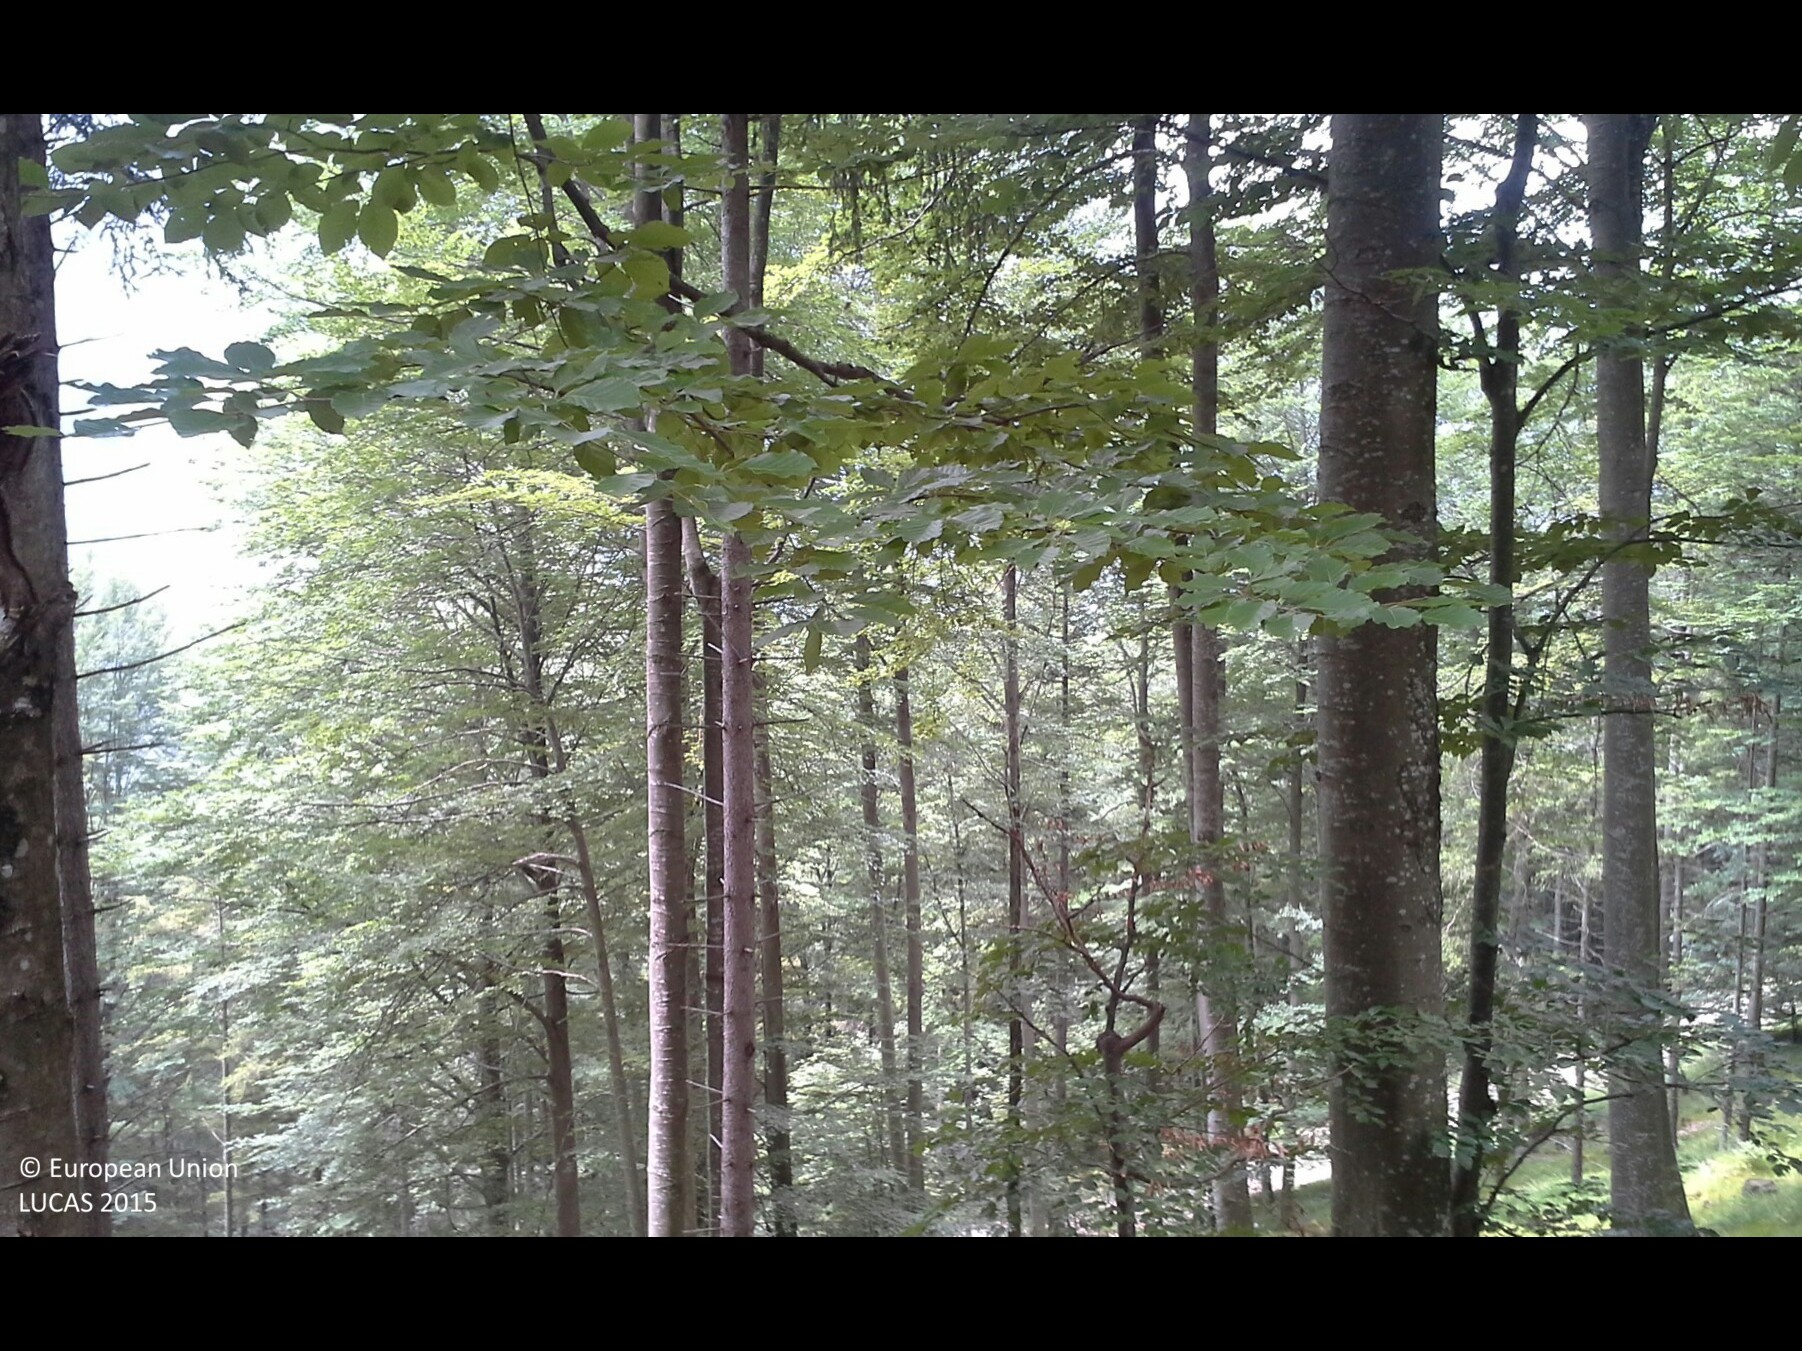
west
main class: Woodland
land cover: Spruce dominated mixed woodland
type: beech forest
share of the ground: > 75 %
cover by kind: broadleaved forest trees 60 %, coniferous forest trees 25 %, herbaceous plants 10 %, unconsolidated bare surface 5 %
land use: Forestry
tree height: > 5 m
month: June
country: AT
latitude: 47.7626
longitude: 13.7746
